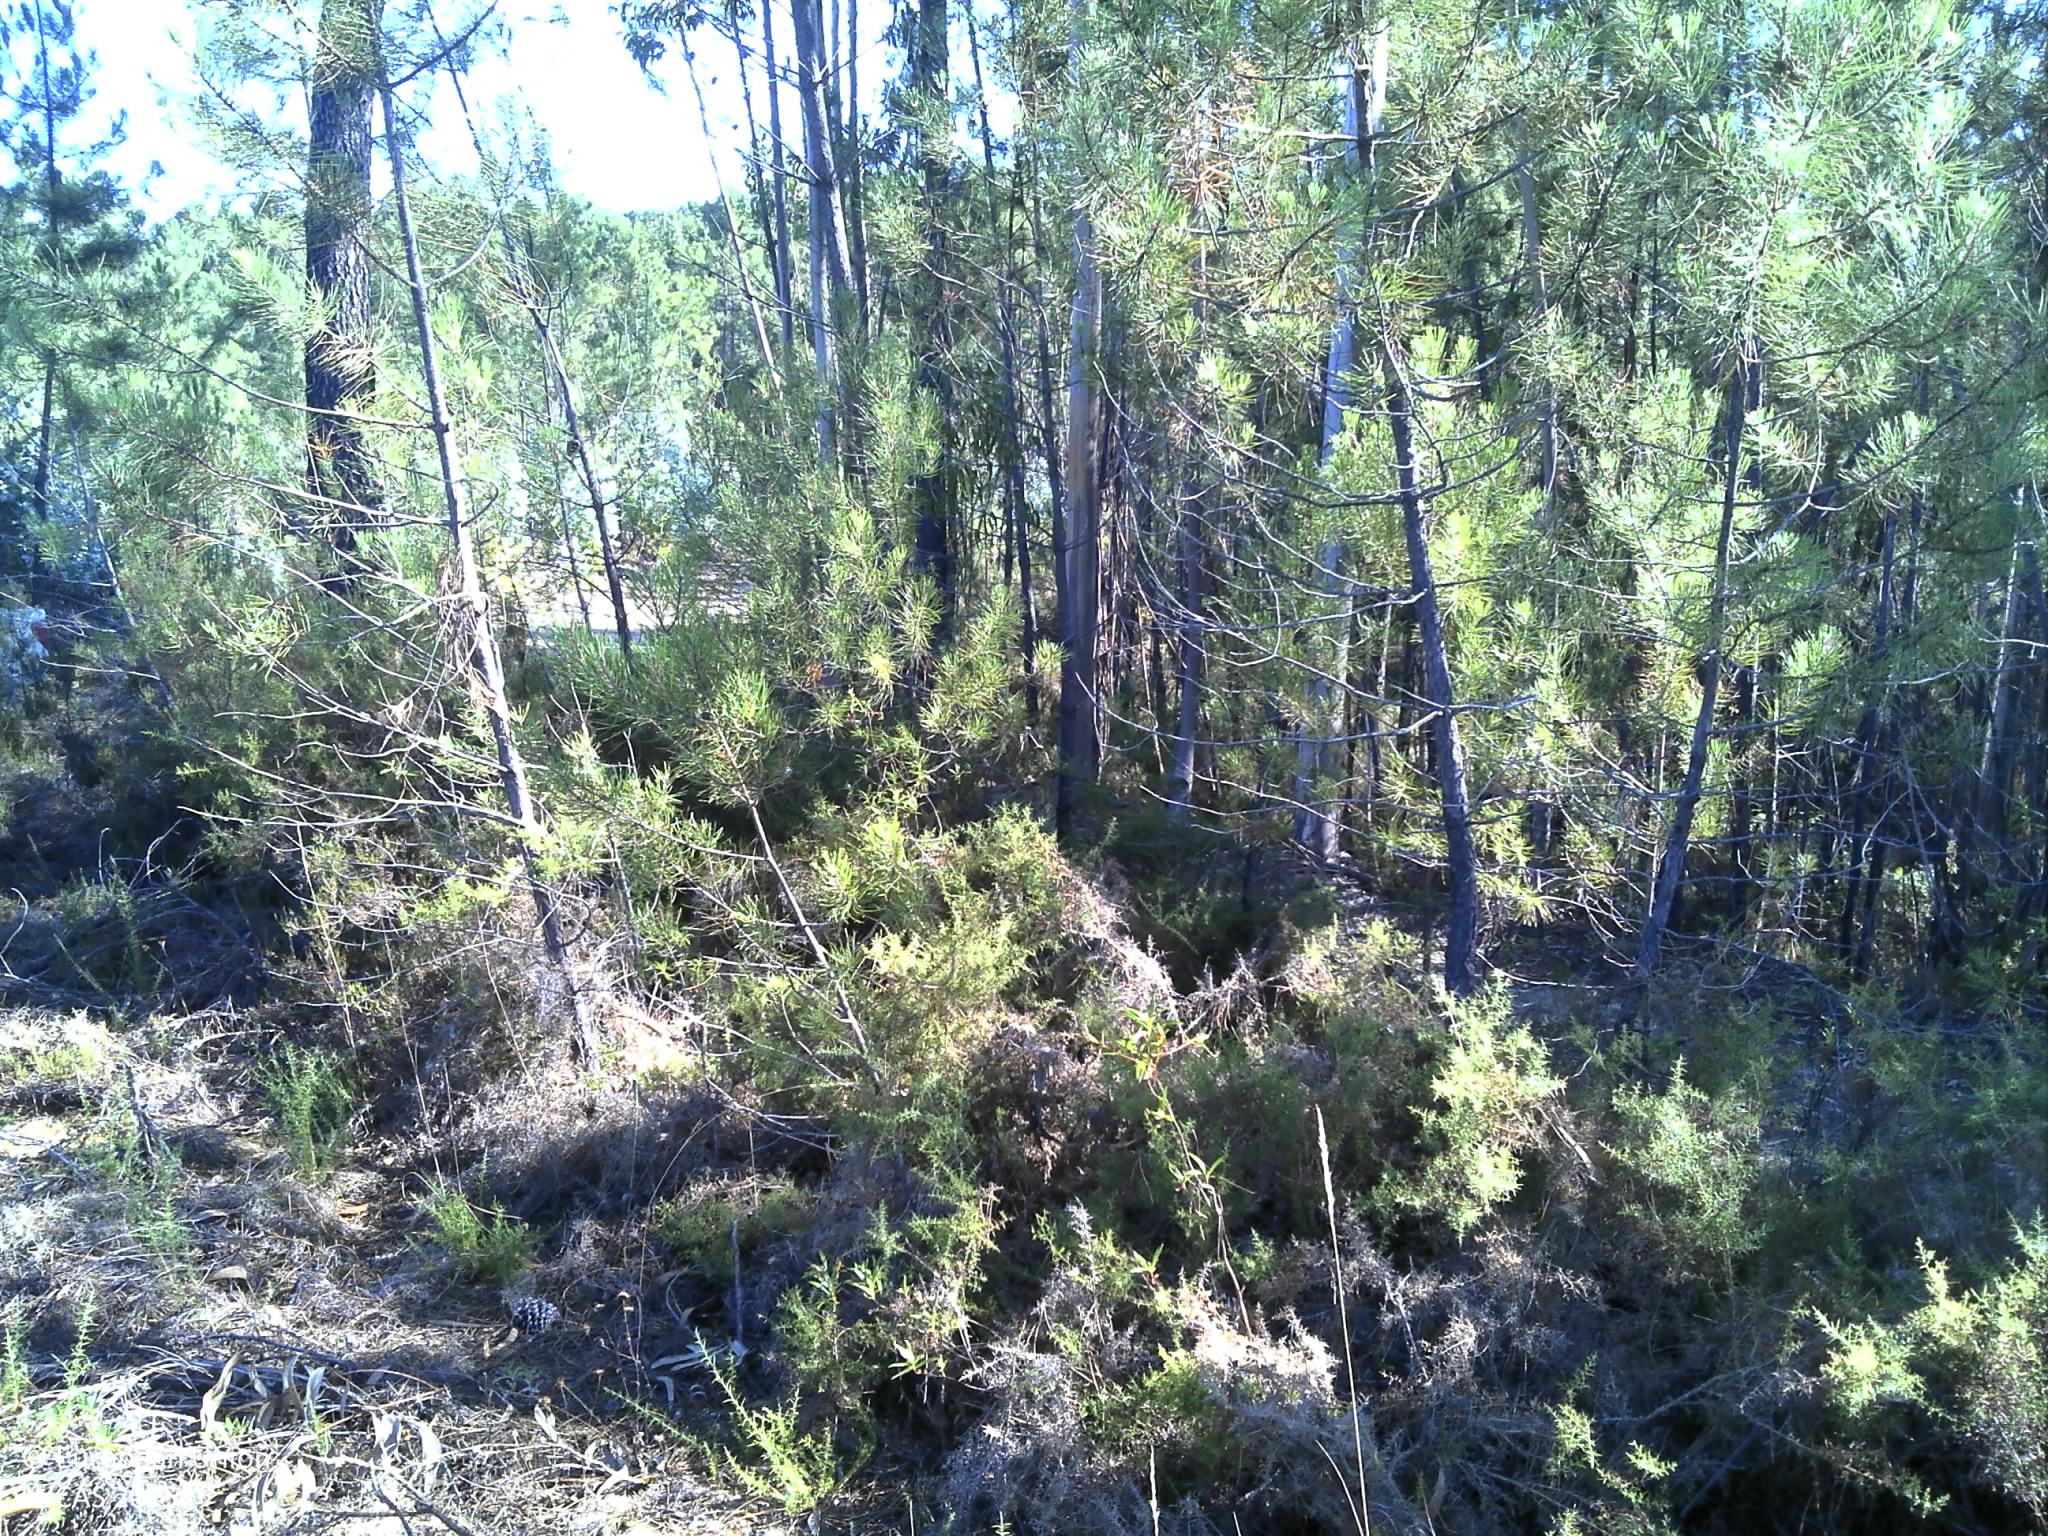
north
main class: Woodland
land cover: Pine dominated coniferous woodland
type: coniferous forest of the mediterranean region
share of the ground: 10 - 25 %
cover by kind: shrubs 70 %, coniferous forest trees 30 %
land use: Forestry
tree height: > 5 m
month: July
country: PT
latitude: 39.7731
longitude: -8.0804
